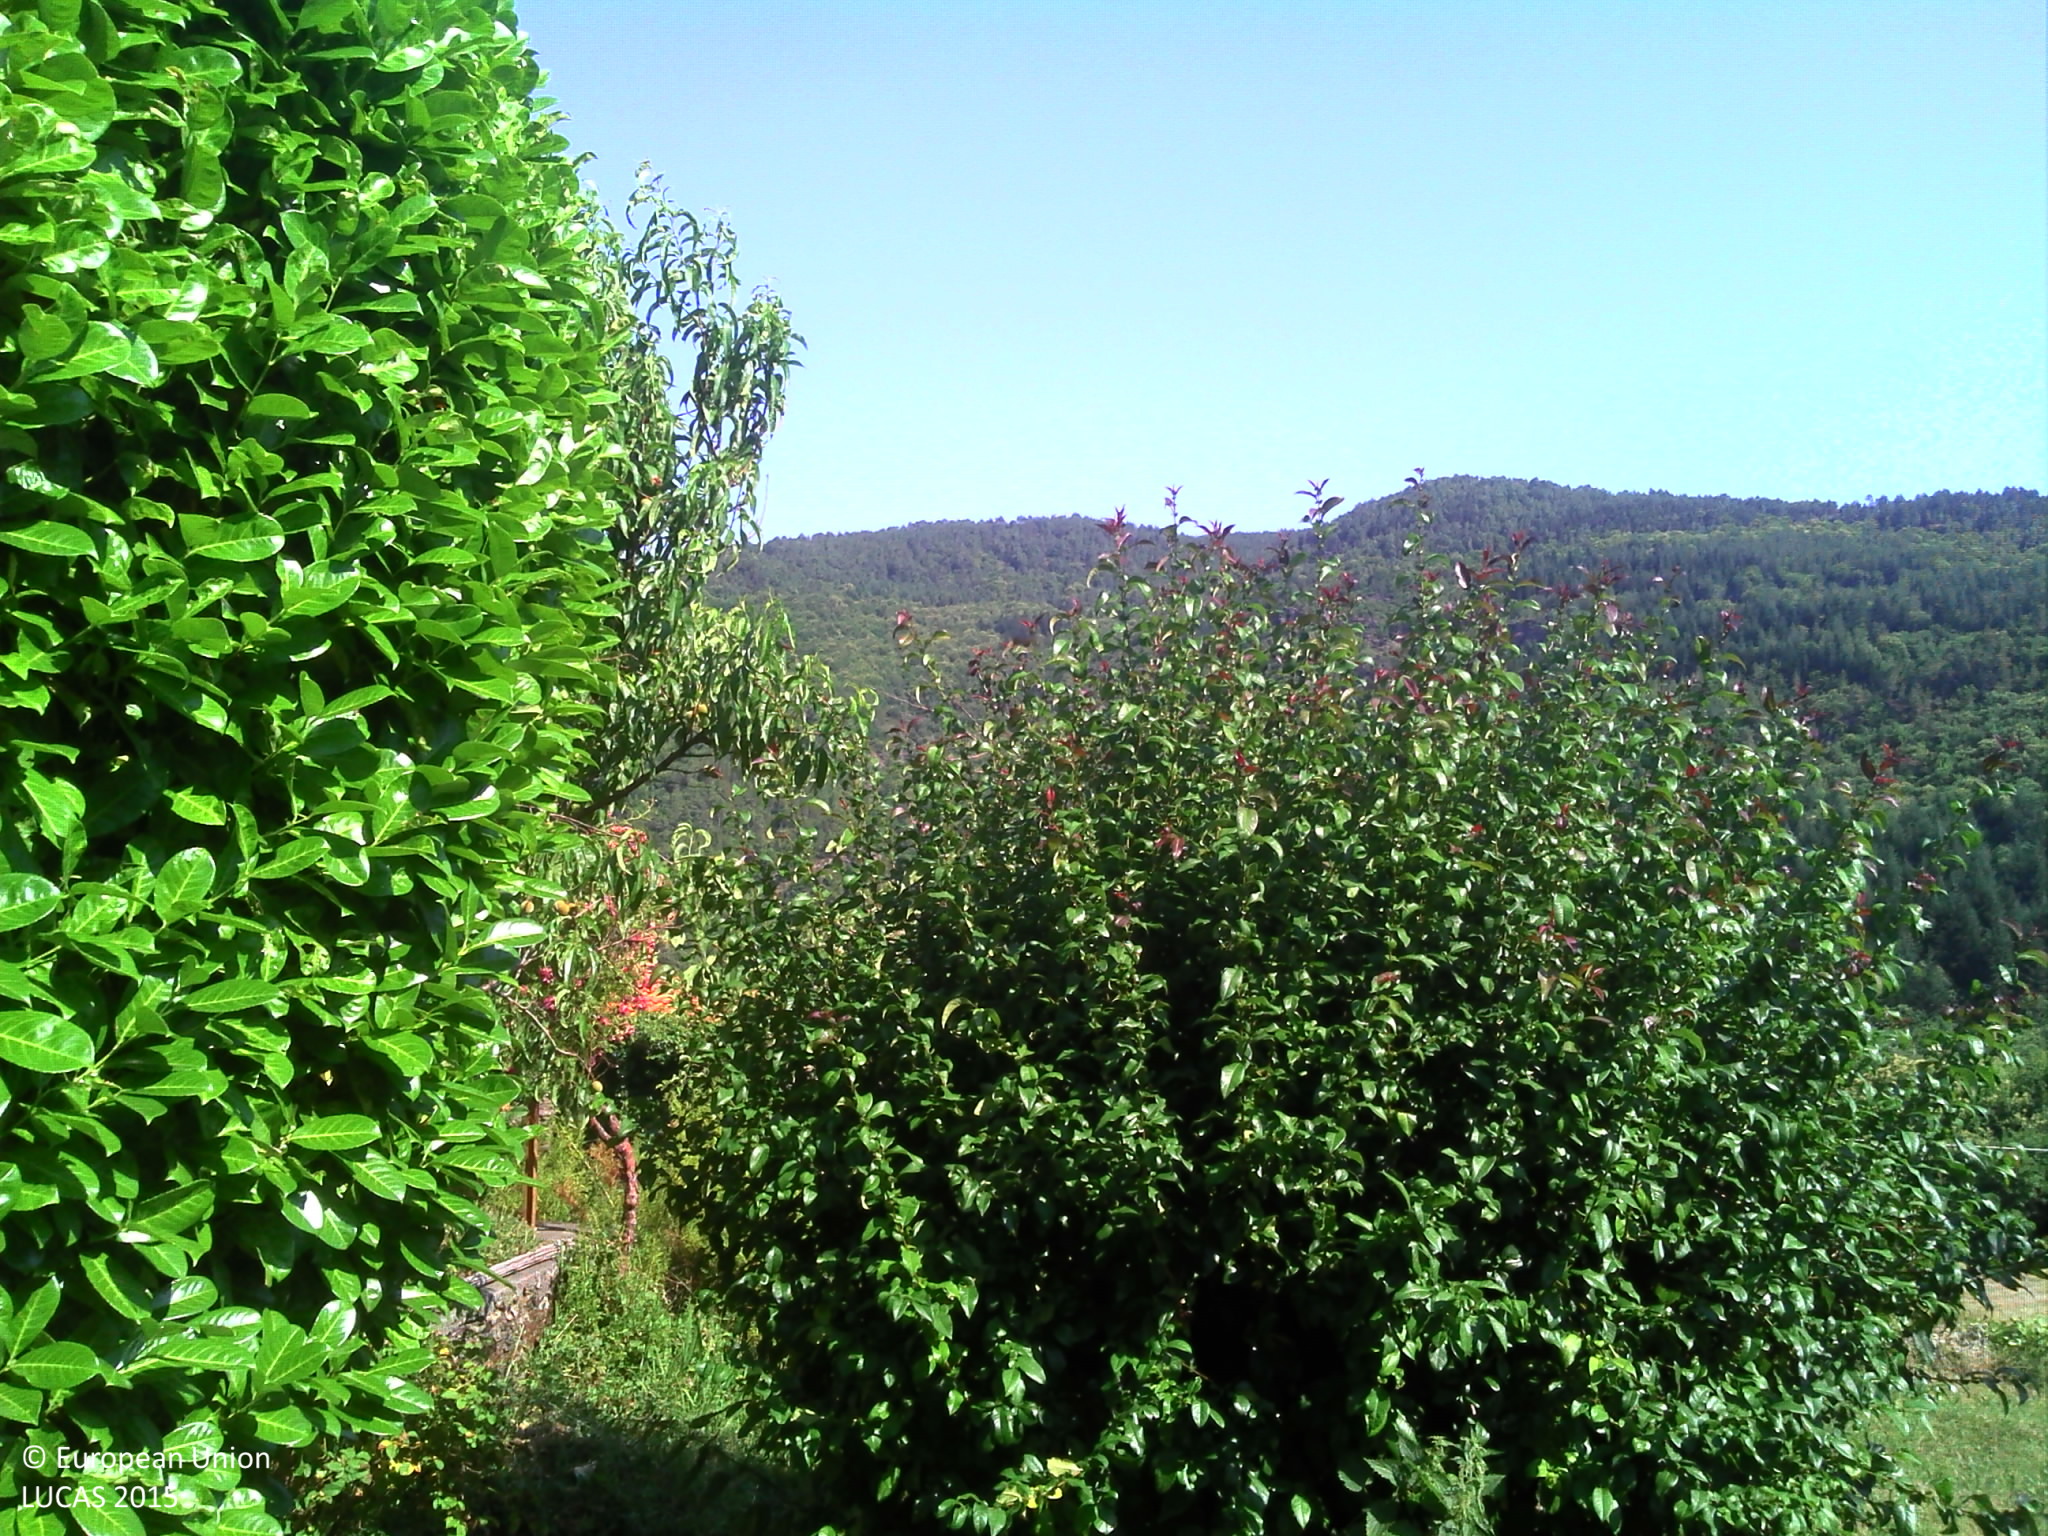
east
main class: Cropland
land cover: Cherry fruit
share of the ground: 25 - 50 %
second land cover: Grassland without tree/shrub cover
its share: 25 - 50 %
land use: Kitchen garden
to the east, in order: Cherry fruit; Grassland without tree/shrub cover; Artificial constructions in urban areas; Grassland with sparse tree/shrub cover; Broadleaved woodland
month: July
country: FR
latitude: 44.2274
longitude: 3.9354
